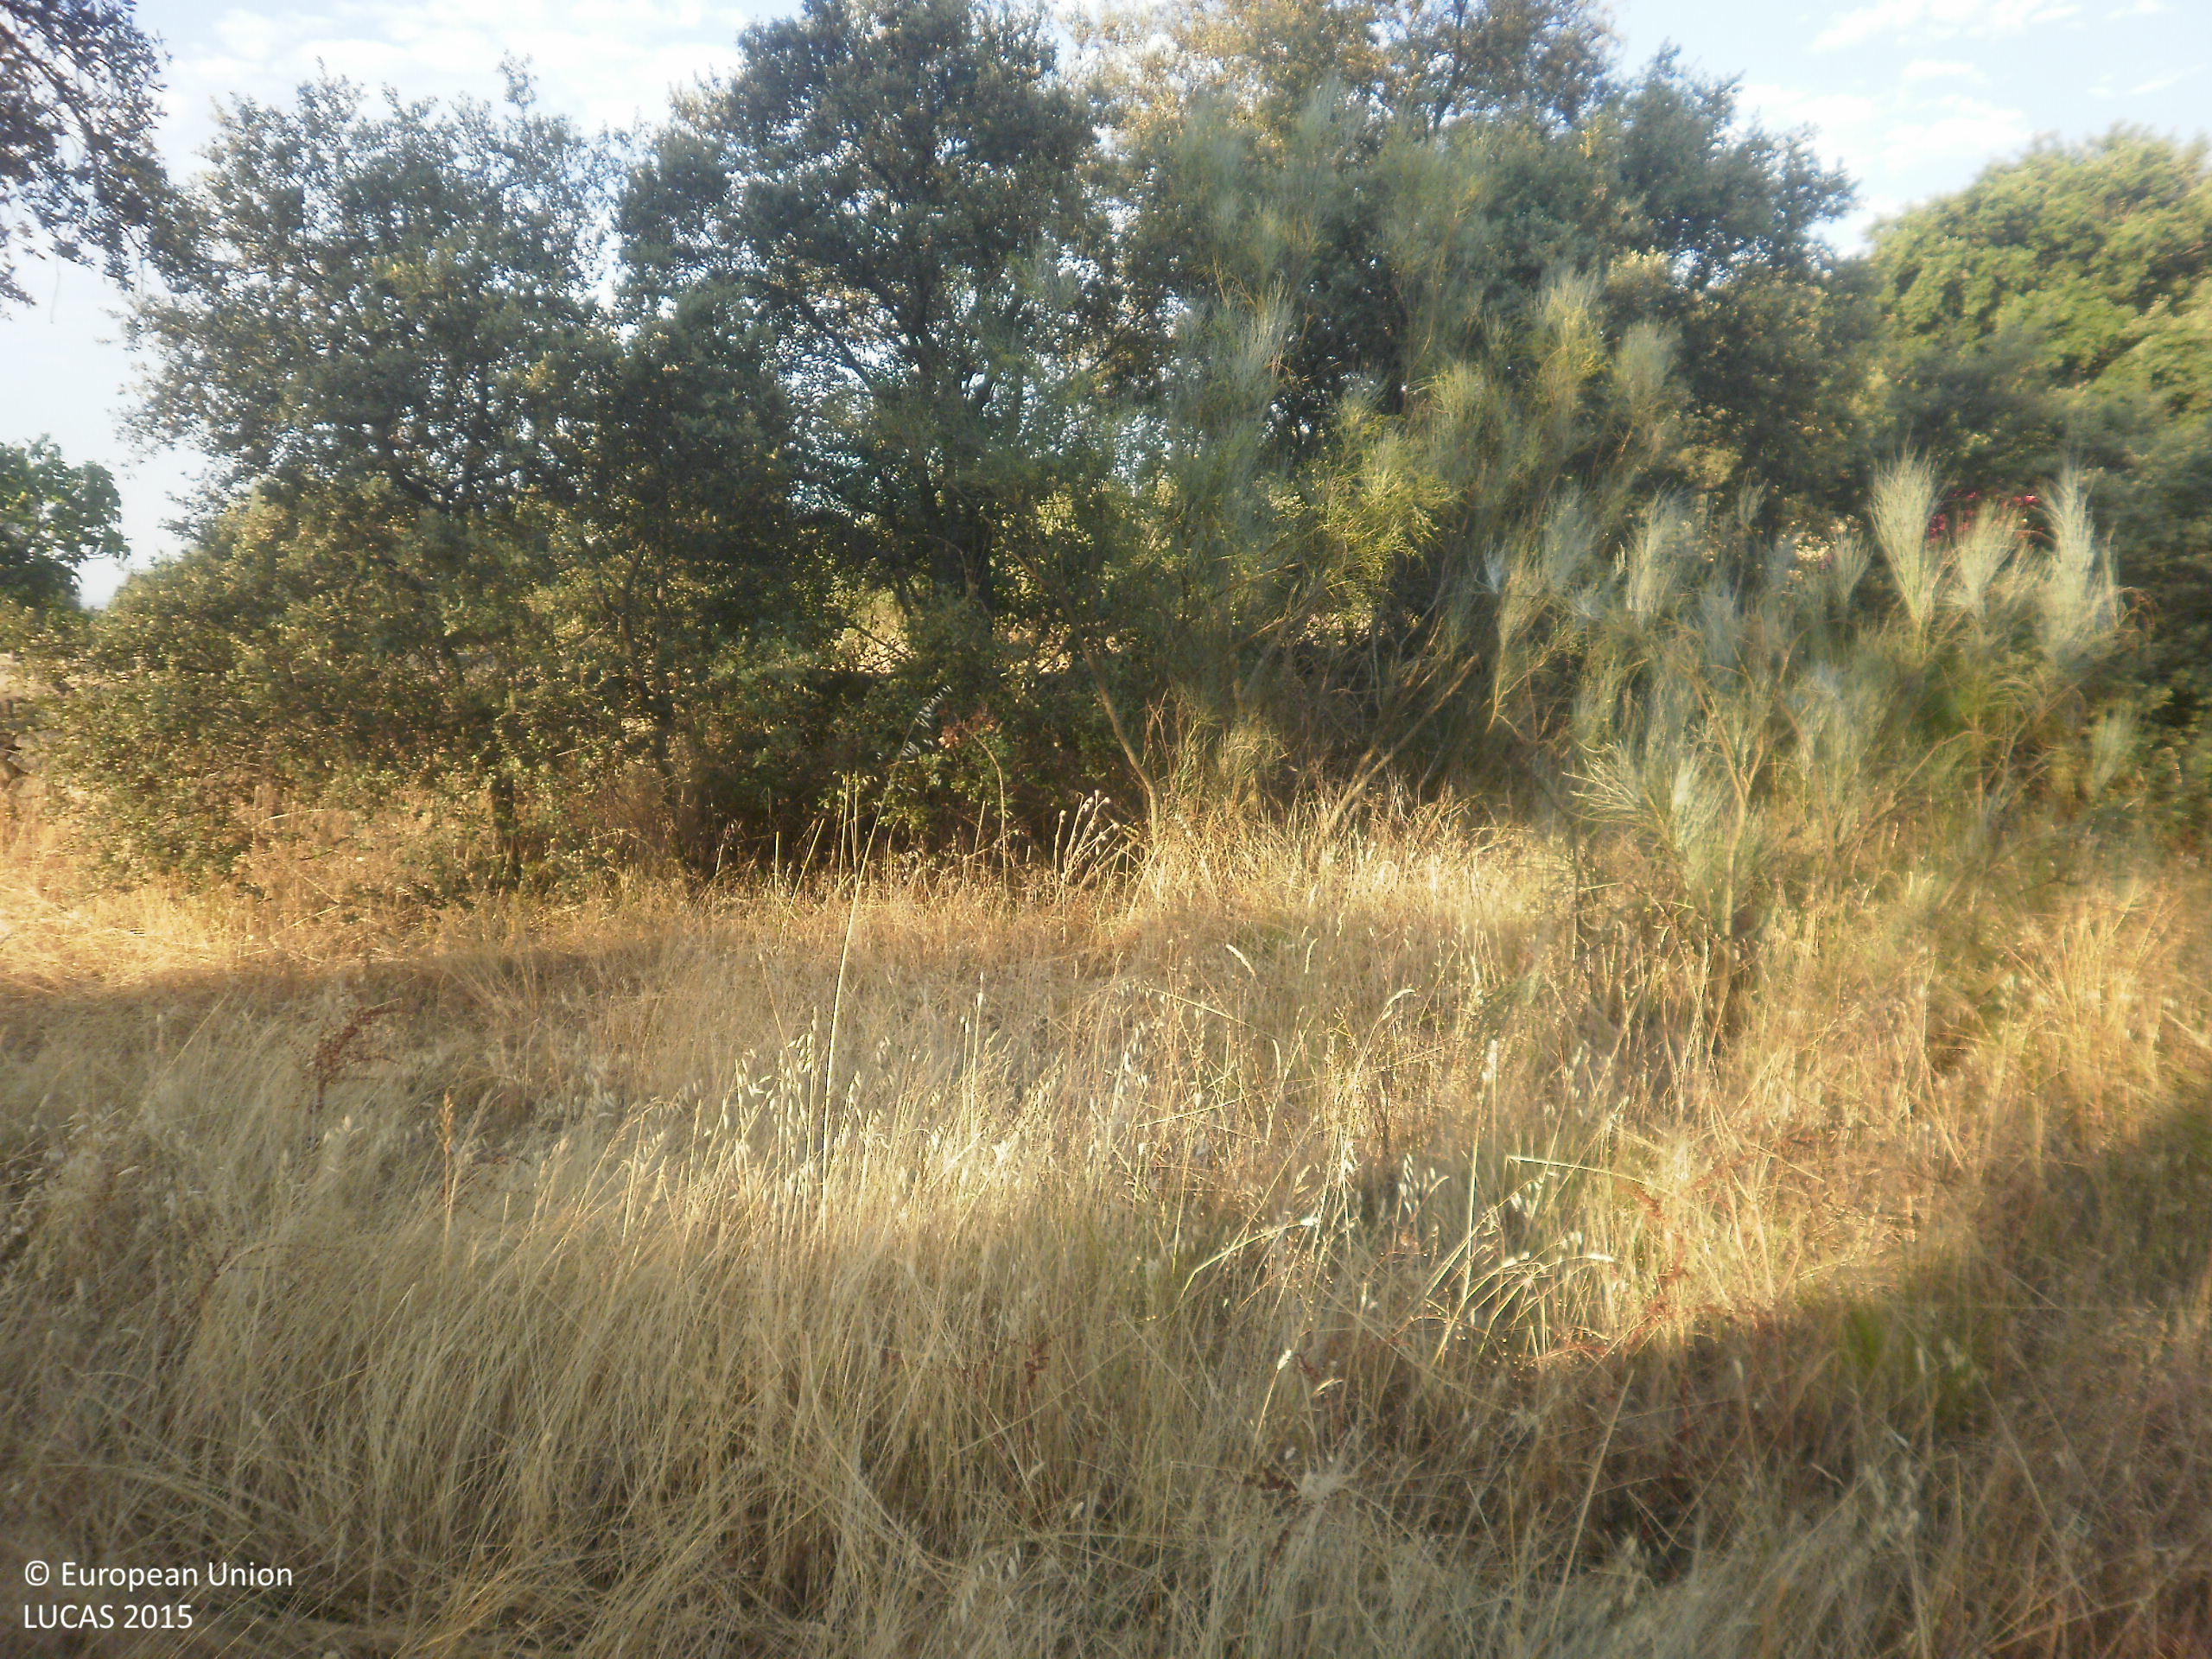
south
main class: Woodland
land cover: Broadleaved woodland
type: broadleaved evergreen forest
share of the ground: 50 - 75 %
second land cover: Grassland without tree/shrub cover
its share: 50 - 75 %
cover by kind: herbaceous plants 70 %, broadleaved forest trees 20 %, shrubs 10 %
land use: Forestry
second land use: Agriculture (excluding fallow land and kitchen gardens)
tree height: > 5 m
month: June
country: ES
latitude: 39.2665
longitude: -5.9464
